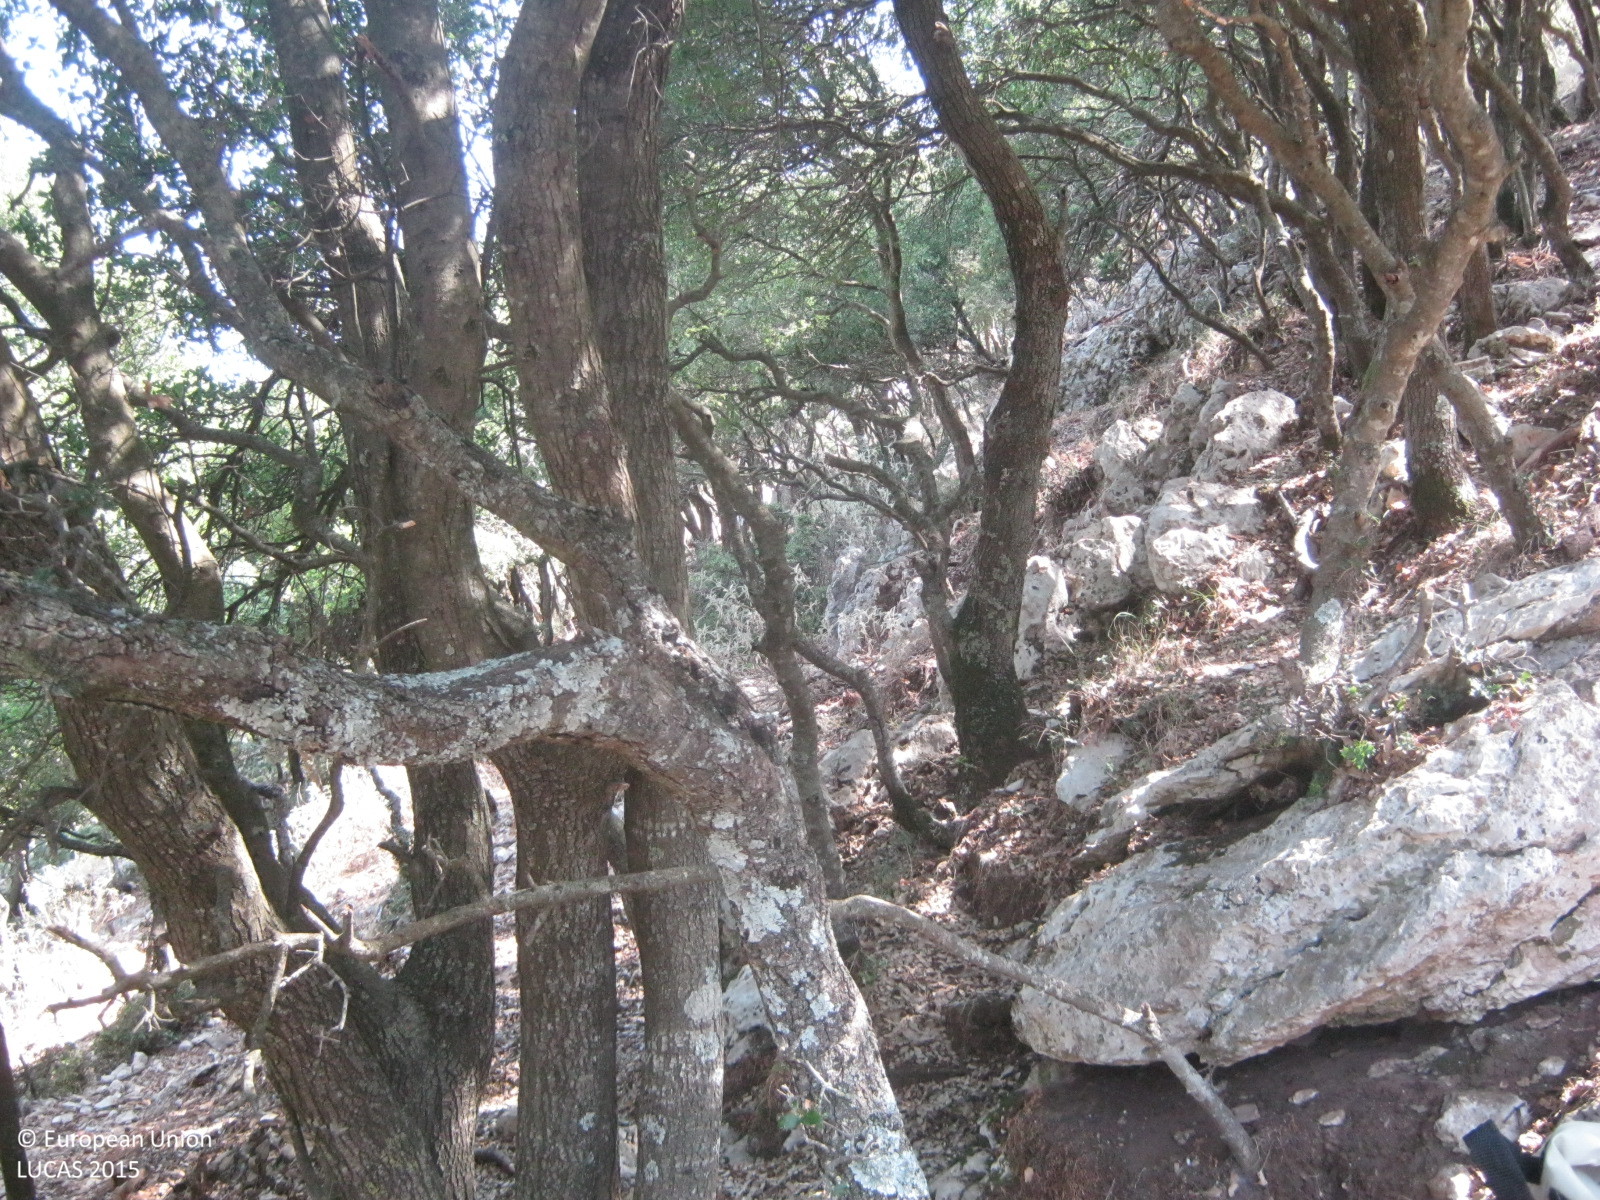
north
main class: Woodland
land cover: Broadleaved woodland
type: broadleaved evergreen forest
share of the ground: > 75 %
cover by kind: broadleaved forest trees 70 %, consolidated bare surface 20 %, shrubs 10 %
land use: Semi-natural and natural areas not in use
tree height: < 5 m
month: August
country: GR
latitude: 38.3110
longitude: 20.5412
